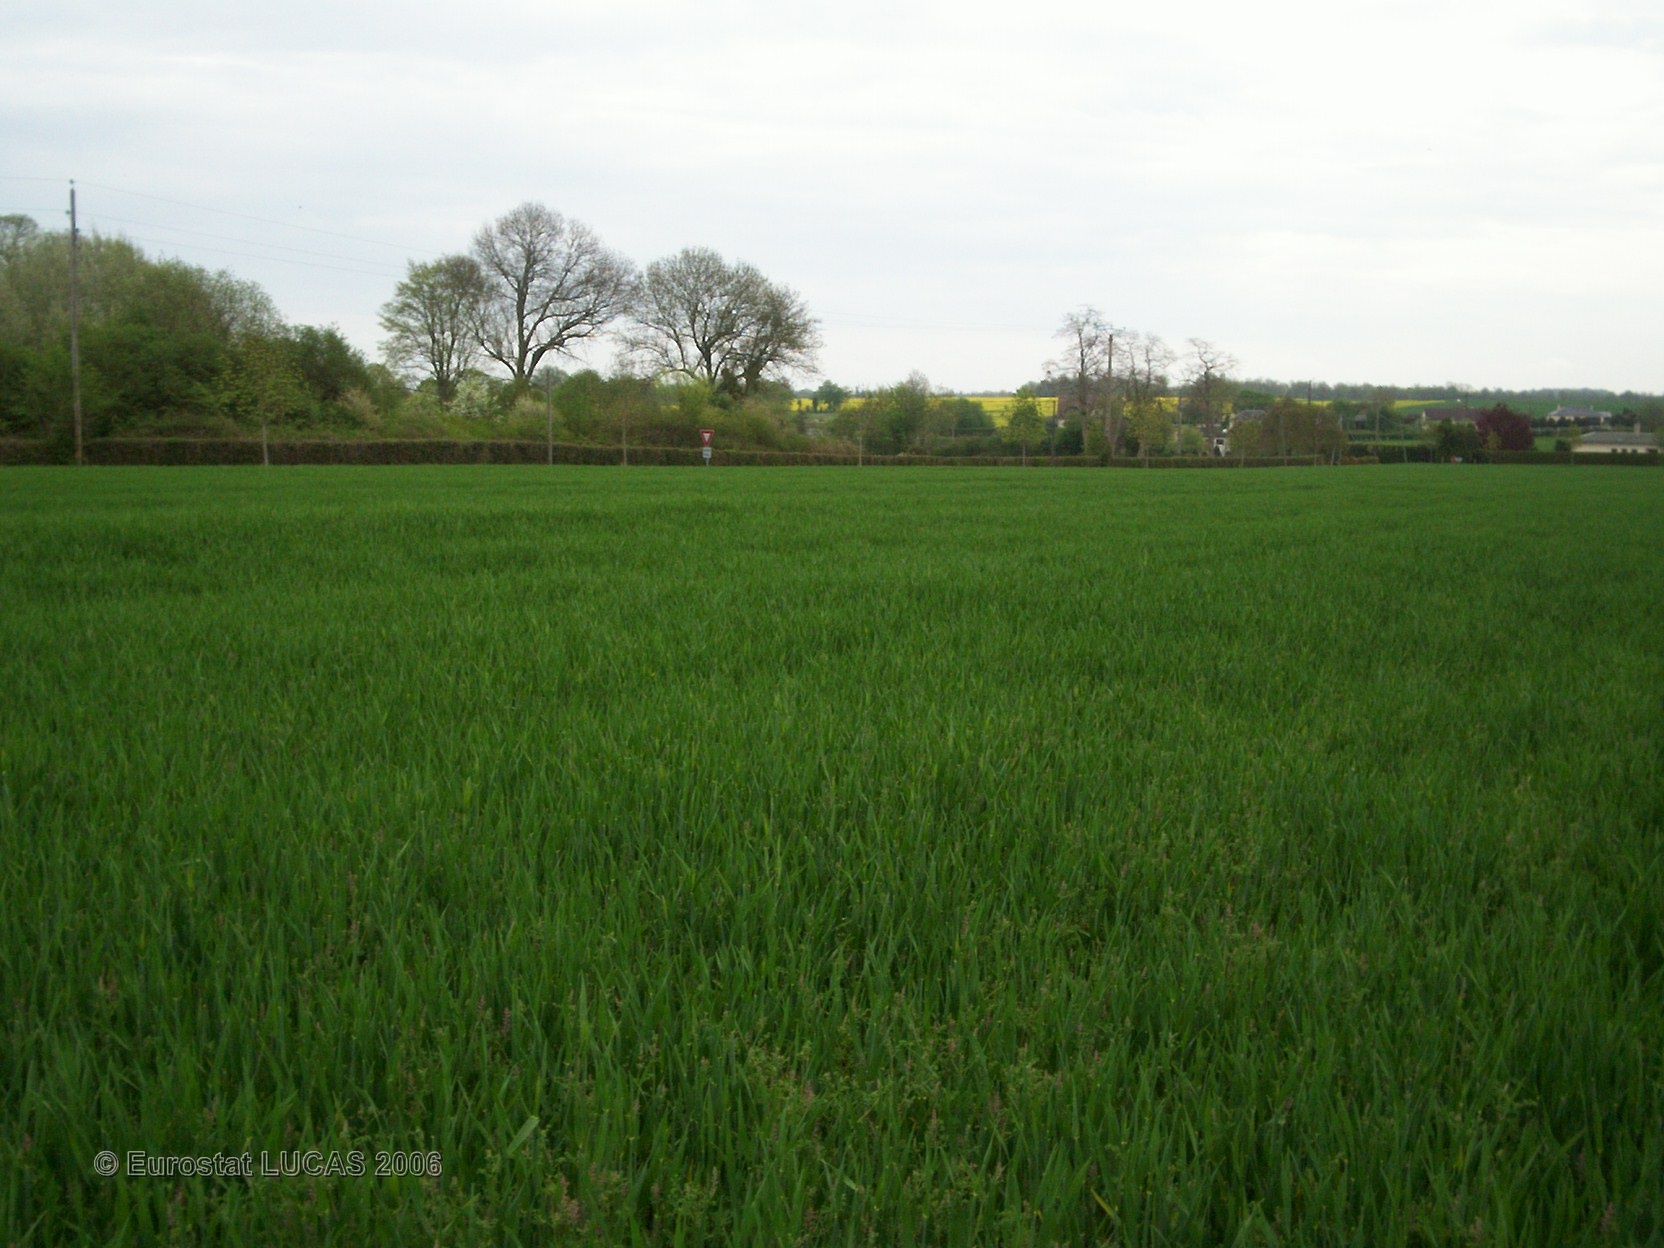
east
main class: Cropland
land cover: Barley
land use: Agriculture (excluding fallow land and kitchen gardens)
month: May
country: FR
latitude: 48.9080
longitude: 0.6020
